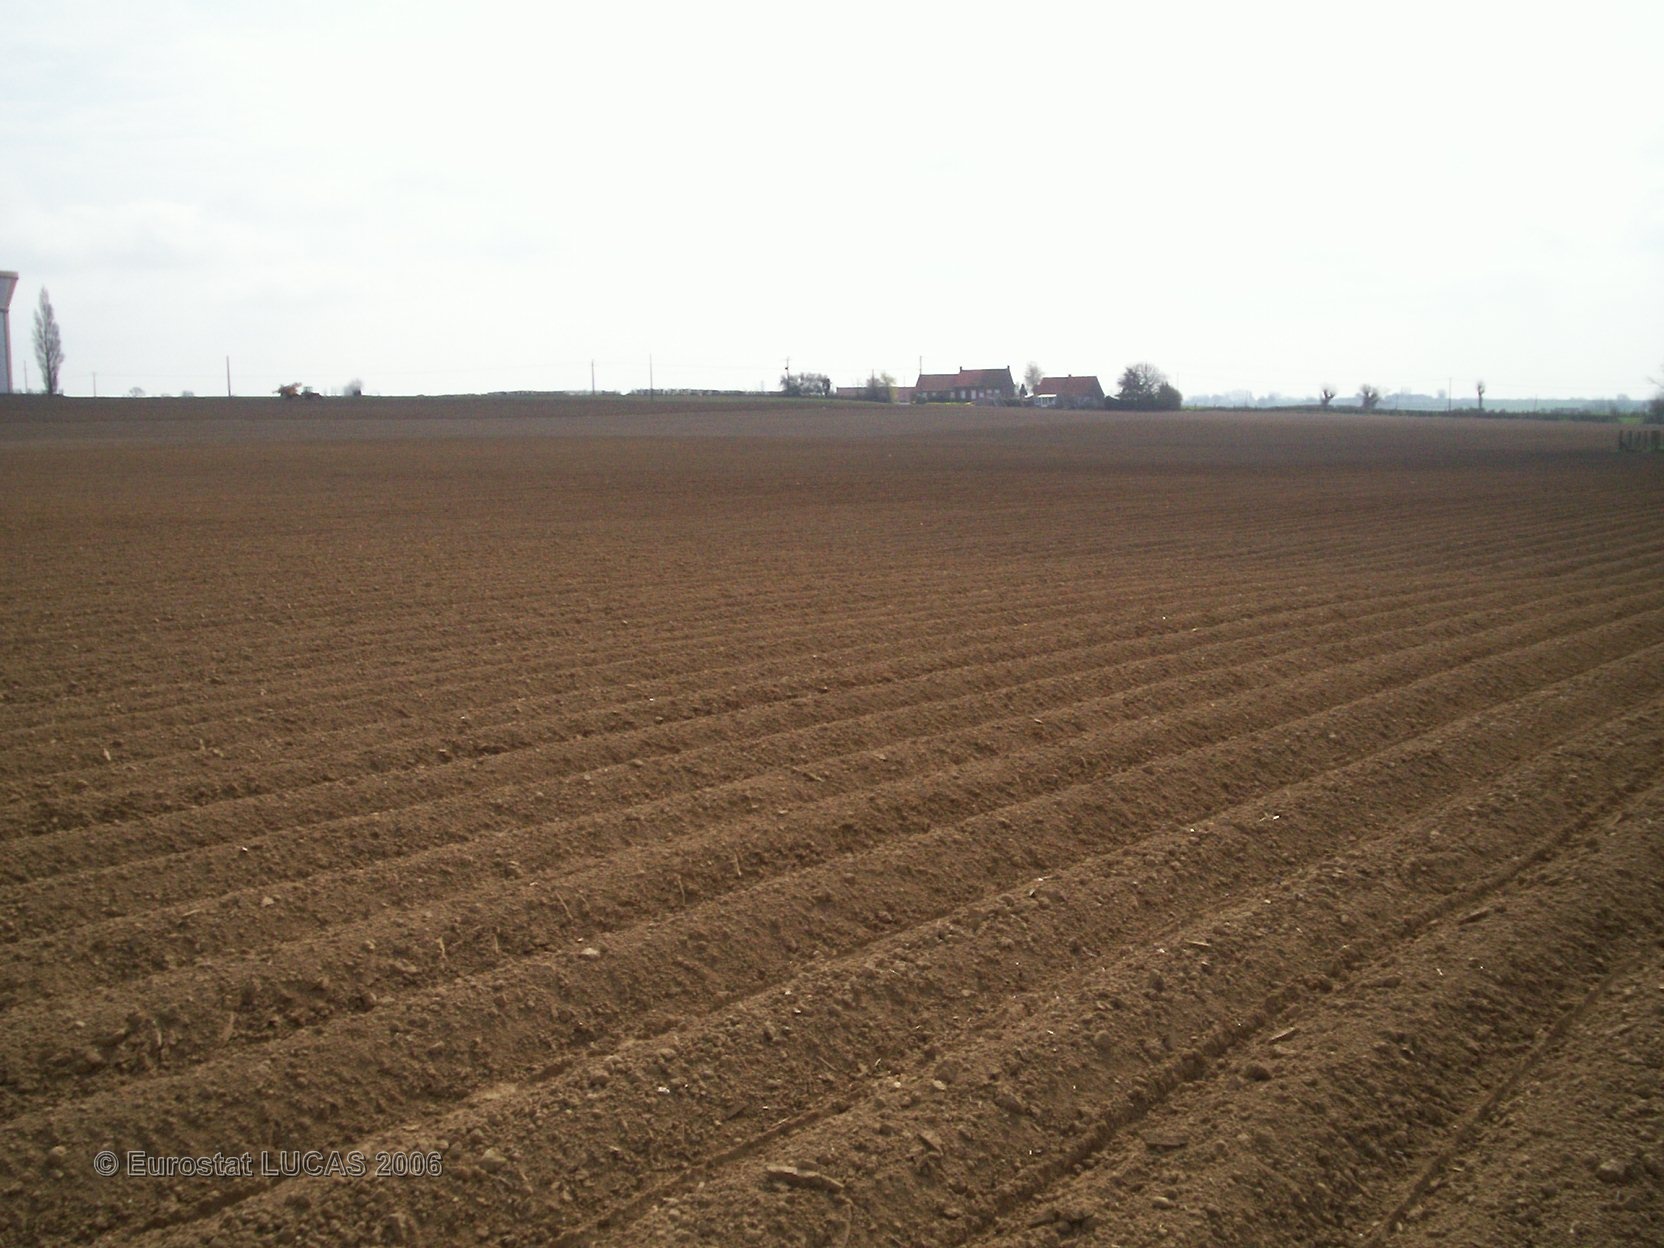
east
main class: Cropland
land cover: Potatoes
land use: Agriculture (excluding fallow land and kitchen gardens)
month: April
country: FR
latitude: 50.7866
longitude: 2.5120
